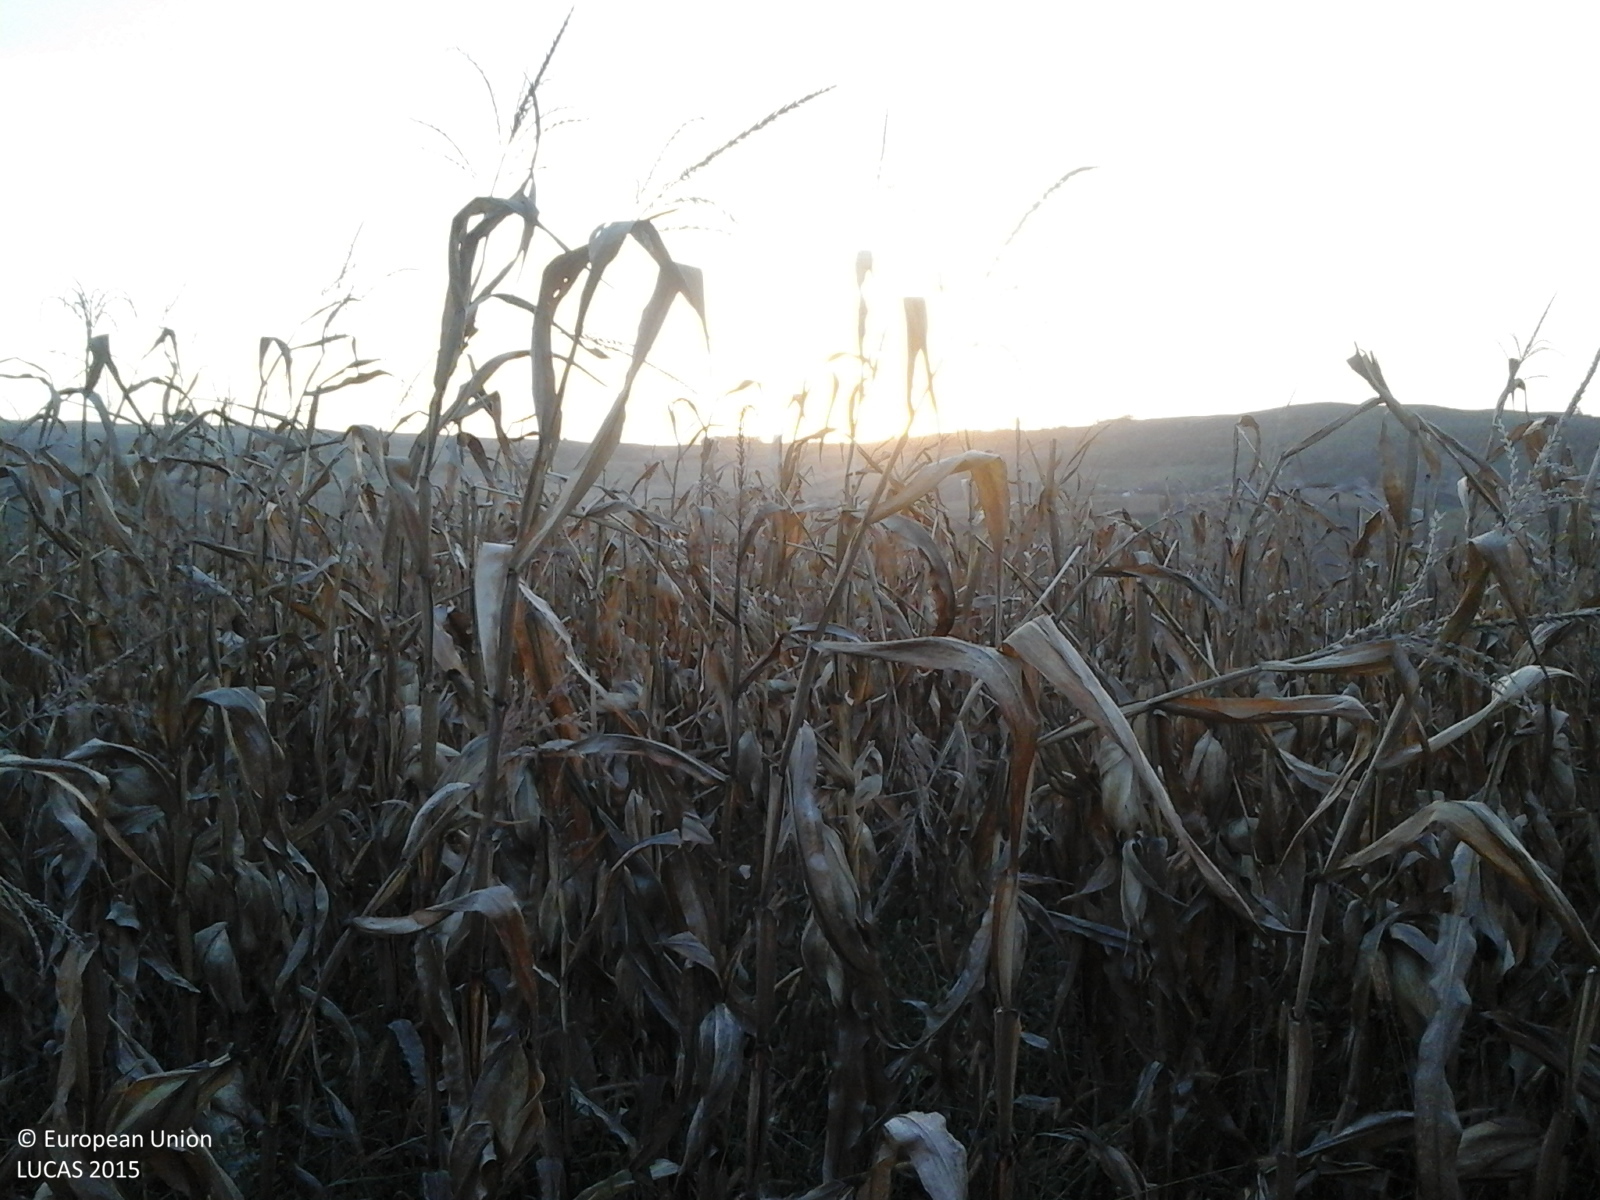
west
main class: Cropland
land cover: Potatoes
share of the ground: < 10 %
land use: Agriculture (excluding fallow land and kitchen gardens)
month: September
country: RO
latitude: 46.5758
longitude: 24.0000
